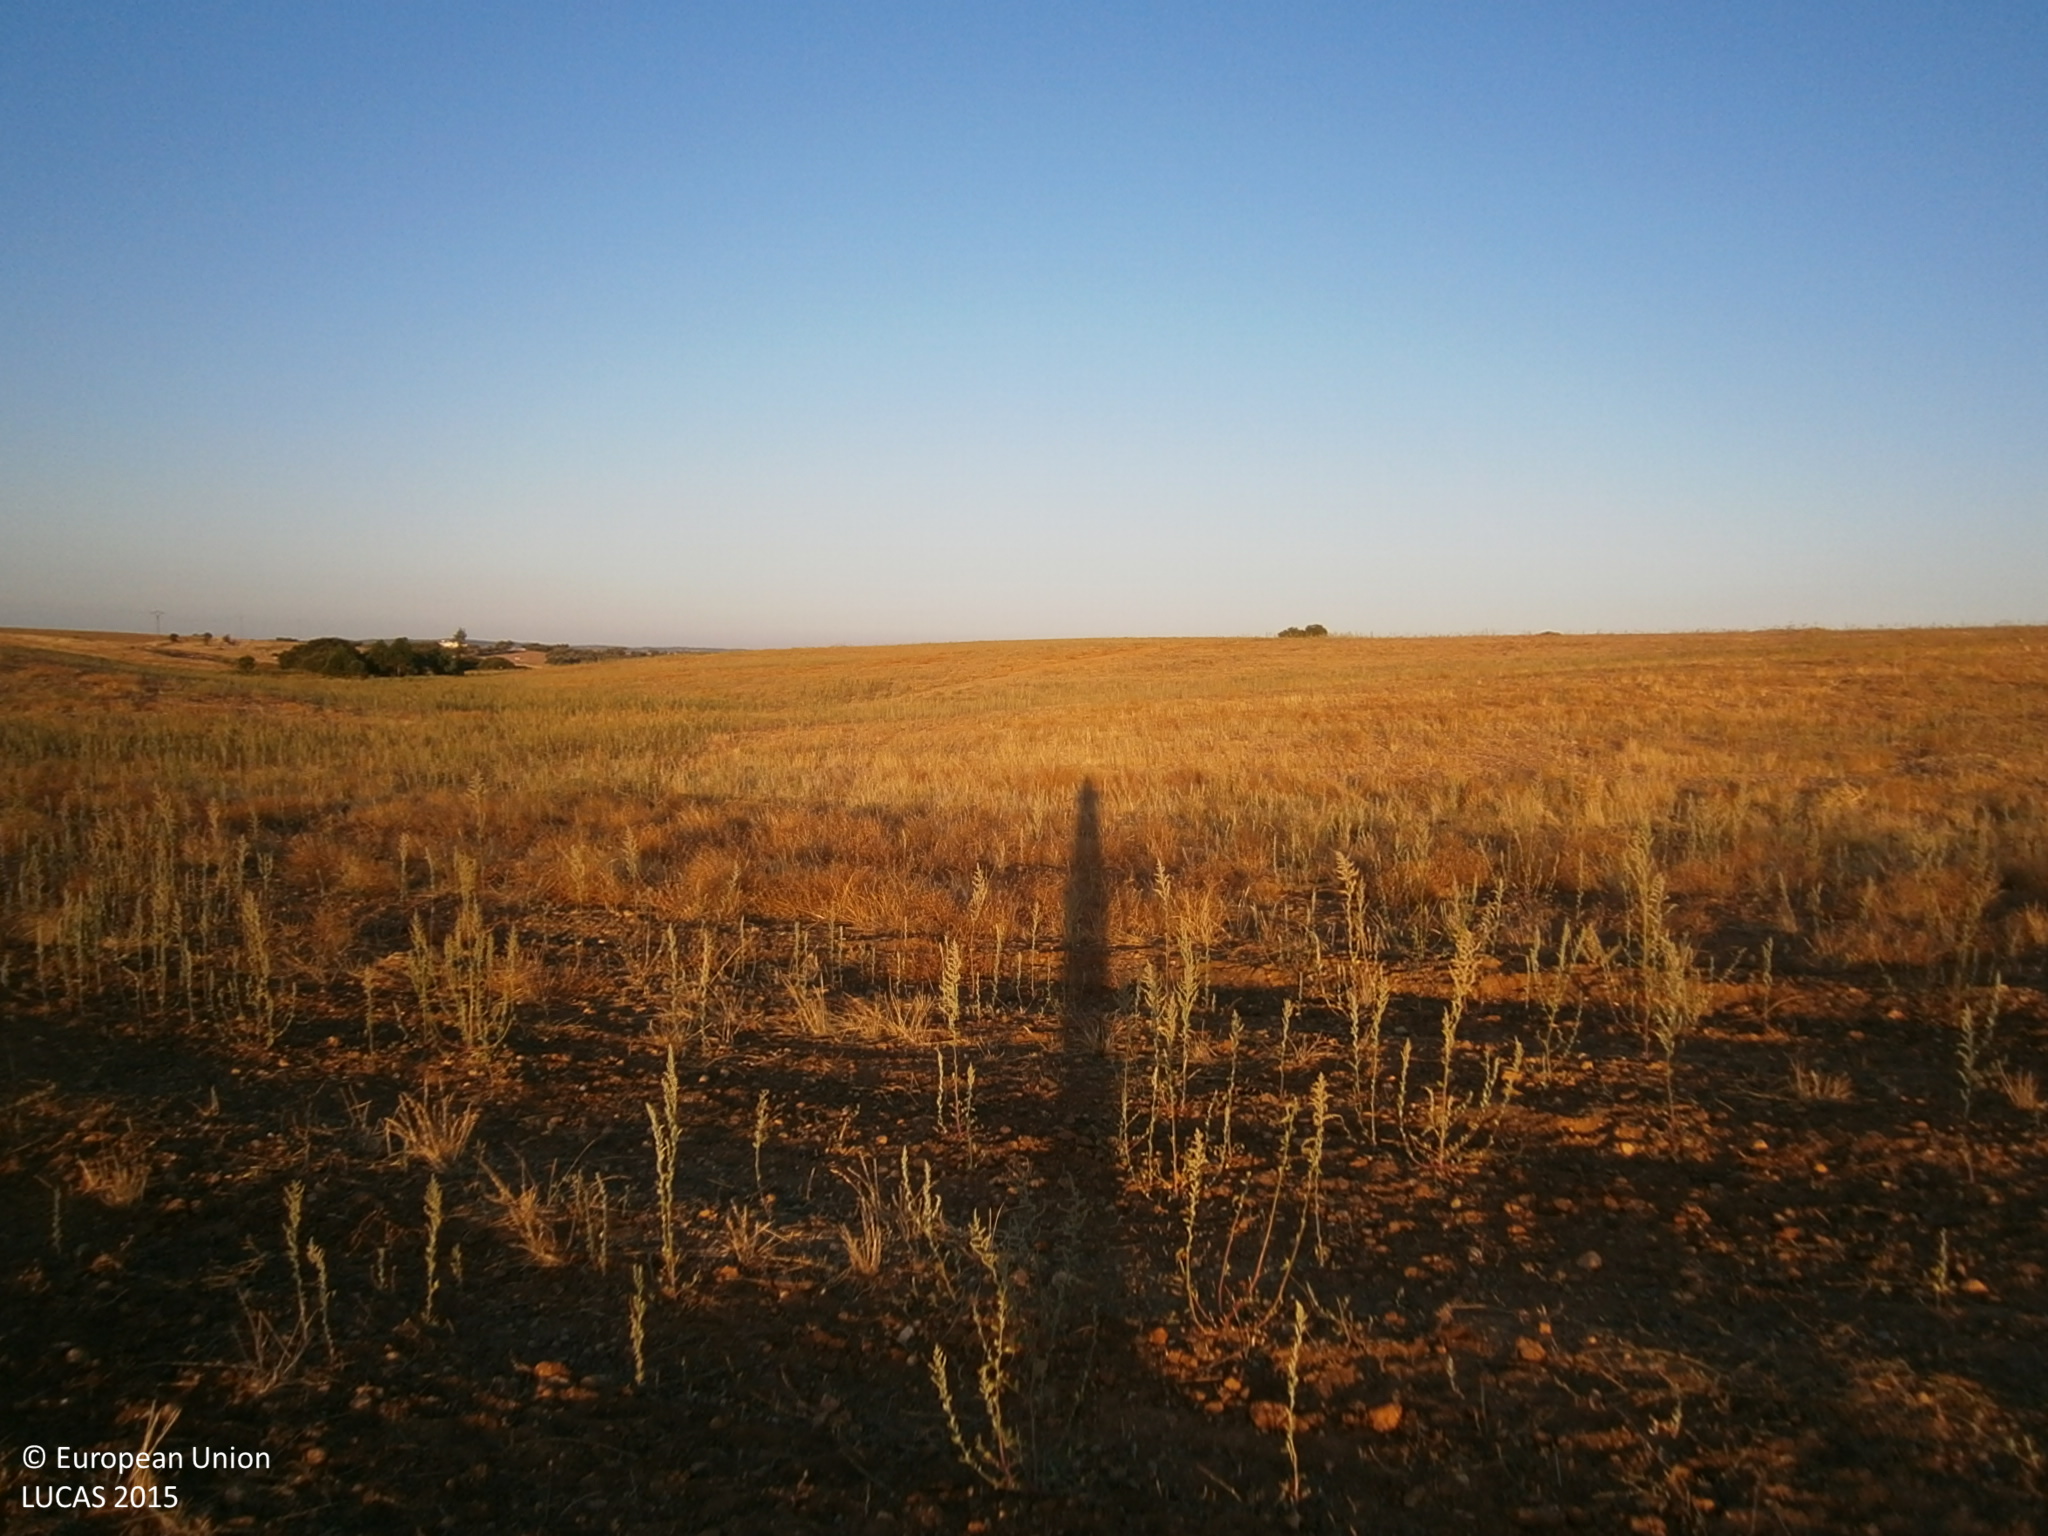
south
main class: Grassland
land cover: Spontaneously vegetated surfaces
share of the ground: > 75 %
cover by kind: herbaceous plants 80 %, unconsolidated bare surface 15 %
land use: Agriculture (excluding fallow land and kitchen gardens)
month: July
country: ES
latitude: 38.6782
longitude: -7.2100
